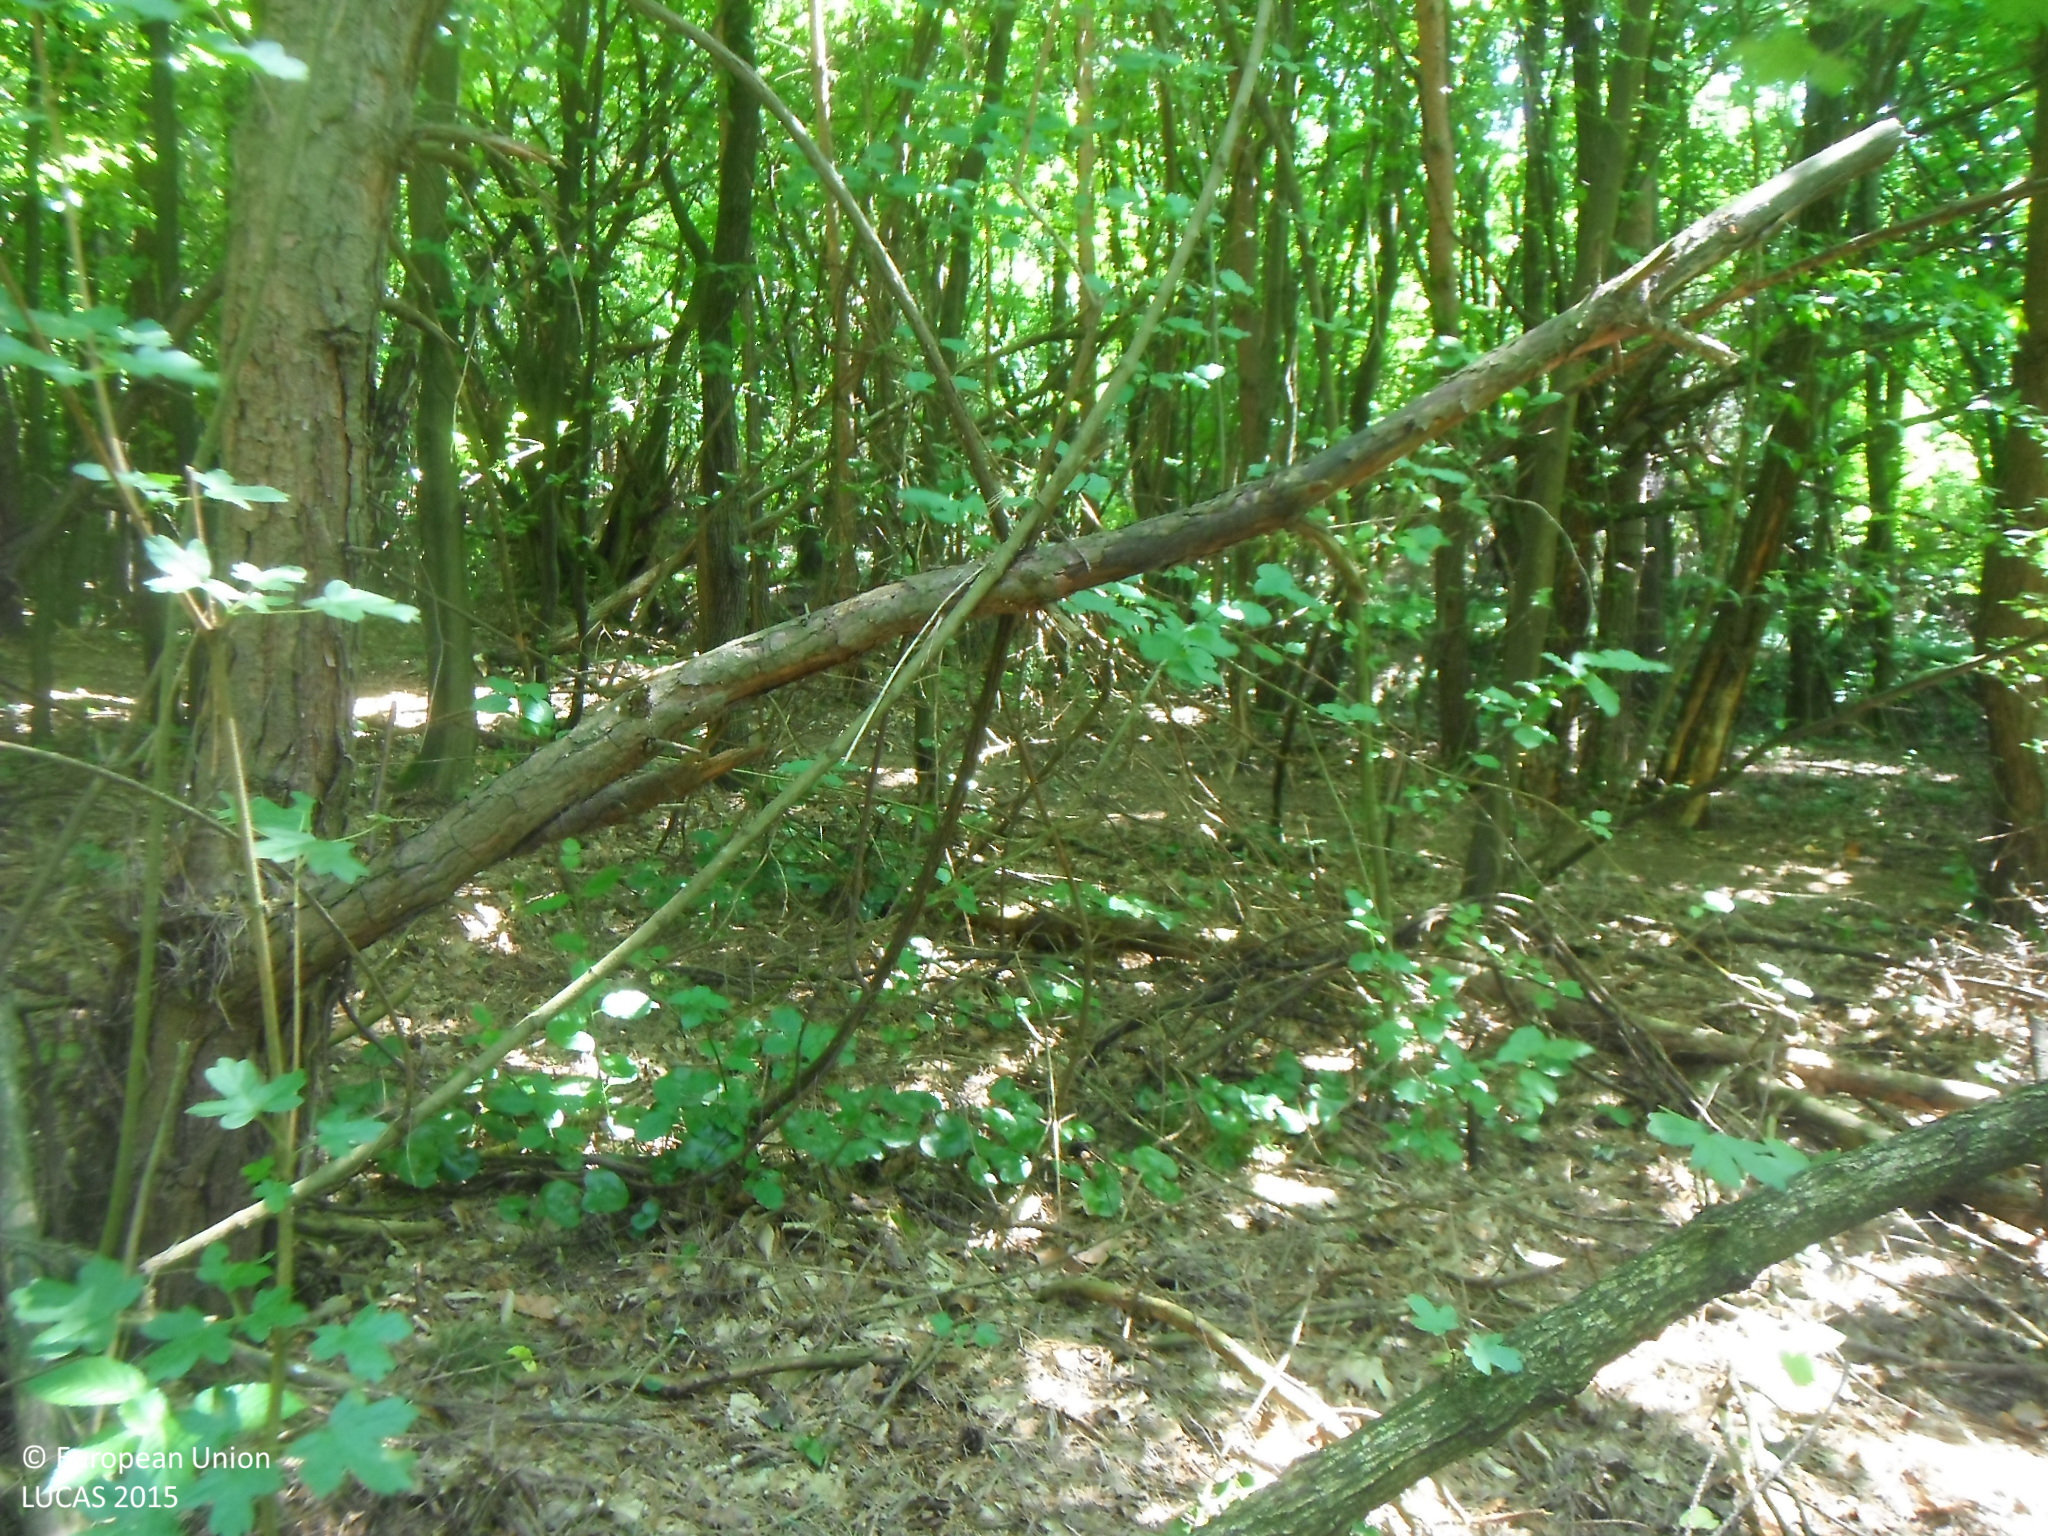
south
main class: Woodland
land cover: Pine dominated mixed woodland
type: beech forest
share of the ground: > 75 %
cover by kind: broadleaved forest trees 70 %, coniferous forest trees 30 %
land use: Forestry
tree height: > 5 m
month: June
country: SK
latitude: 49.0081
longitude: 21.6019
